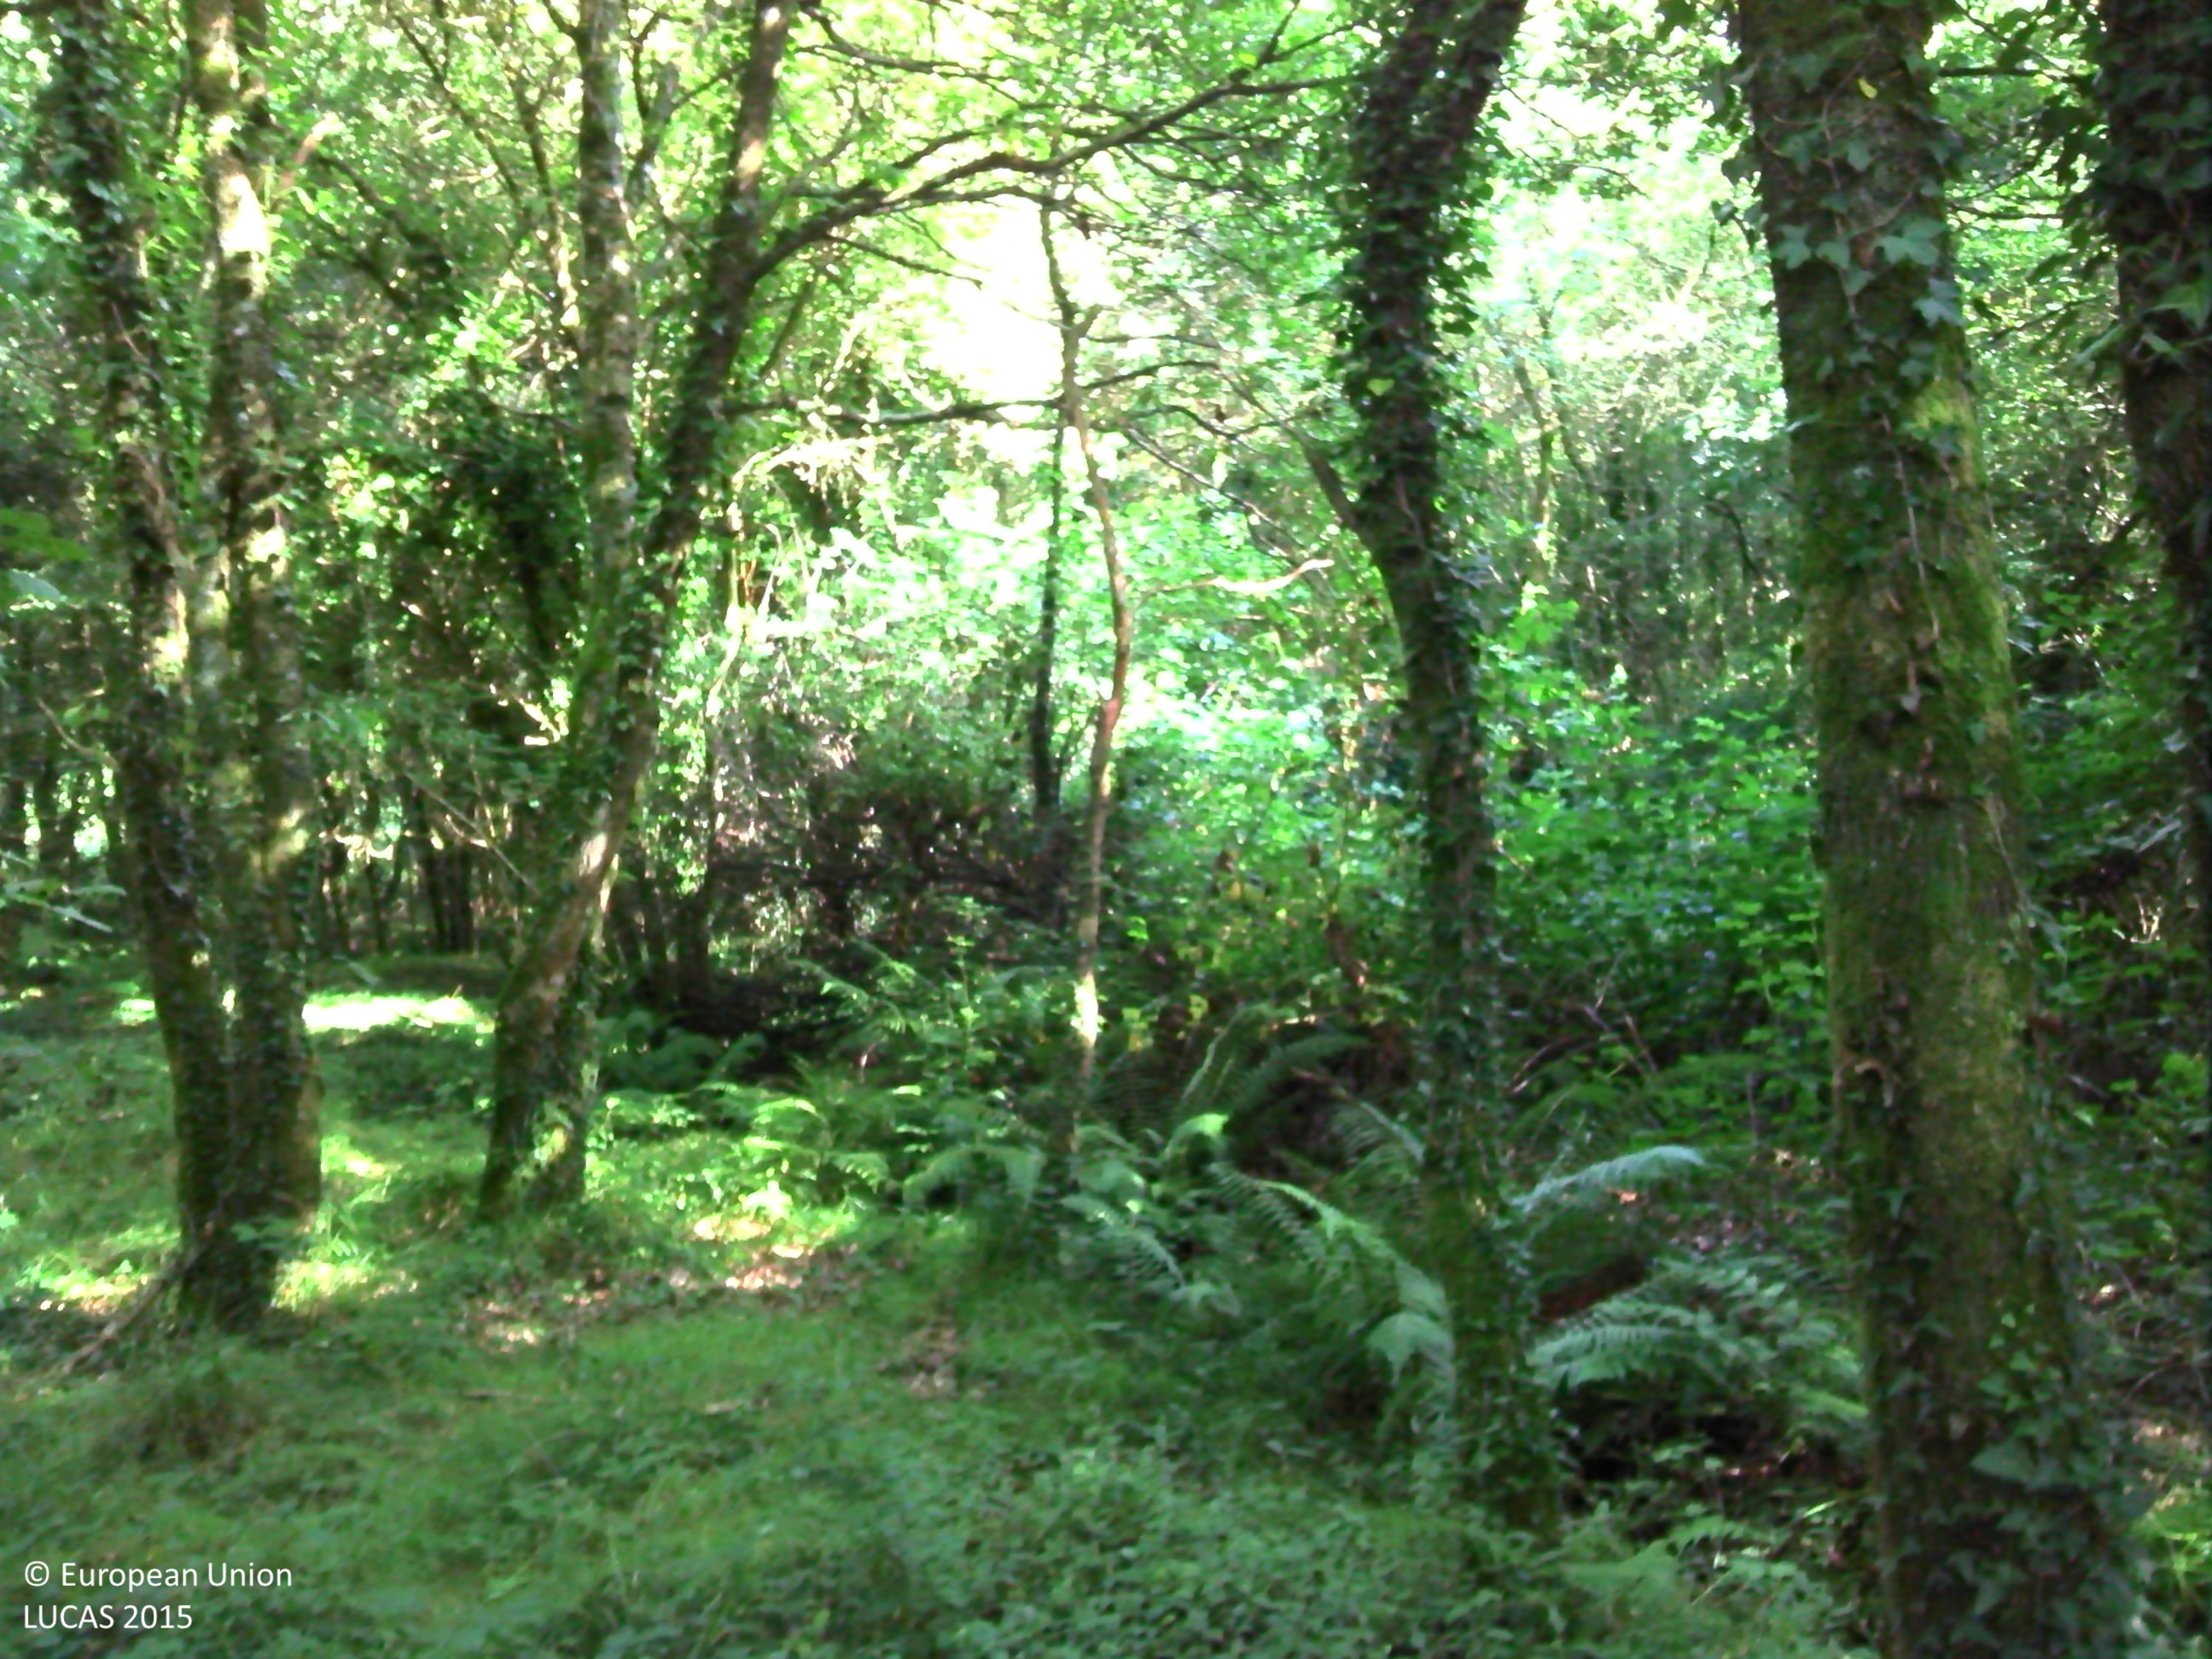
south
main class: Woodland
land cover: Broadleaved woodland
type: acidophilous oak and oak-birch forest
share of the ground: > 75 %
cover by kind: broadleaved forest trees 70 %, shrubs 10 %, herbaceous plants 10 %, lichens and mosses 5 %, consolidated bare surface 5 %
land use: Forestry
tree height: > 5 m
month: July
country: FR
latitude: 47.9018
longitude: -3.0303
